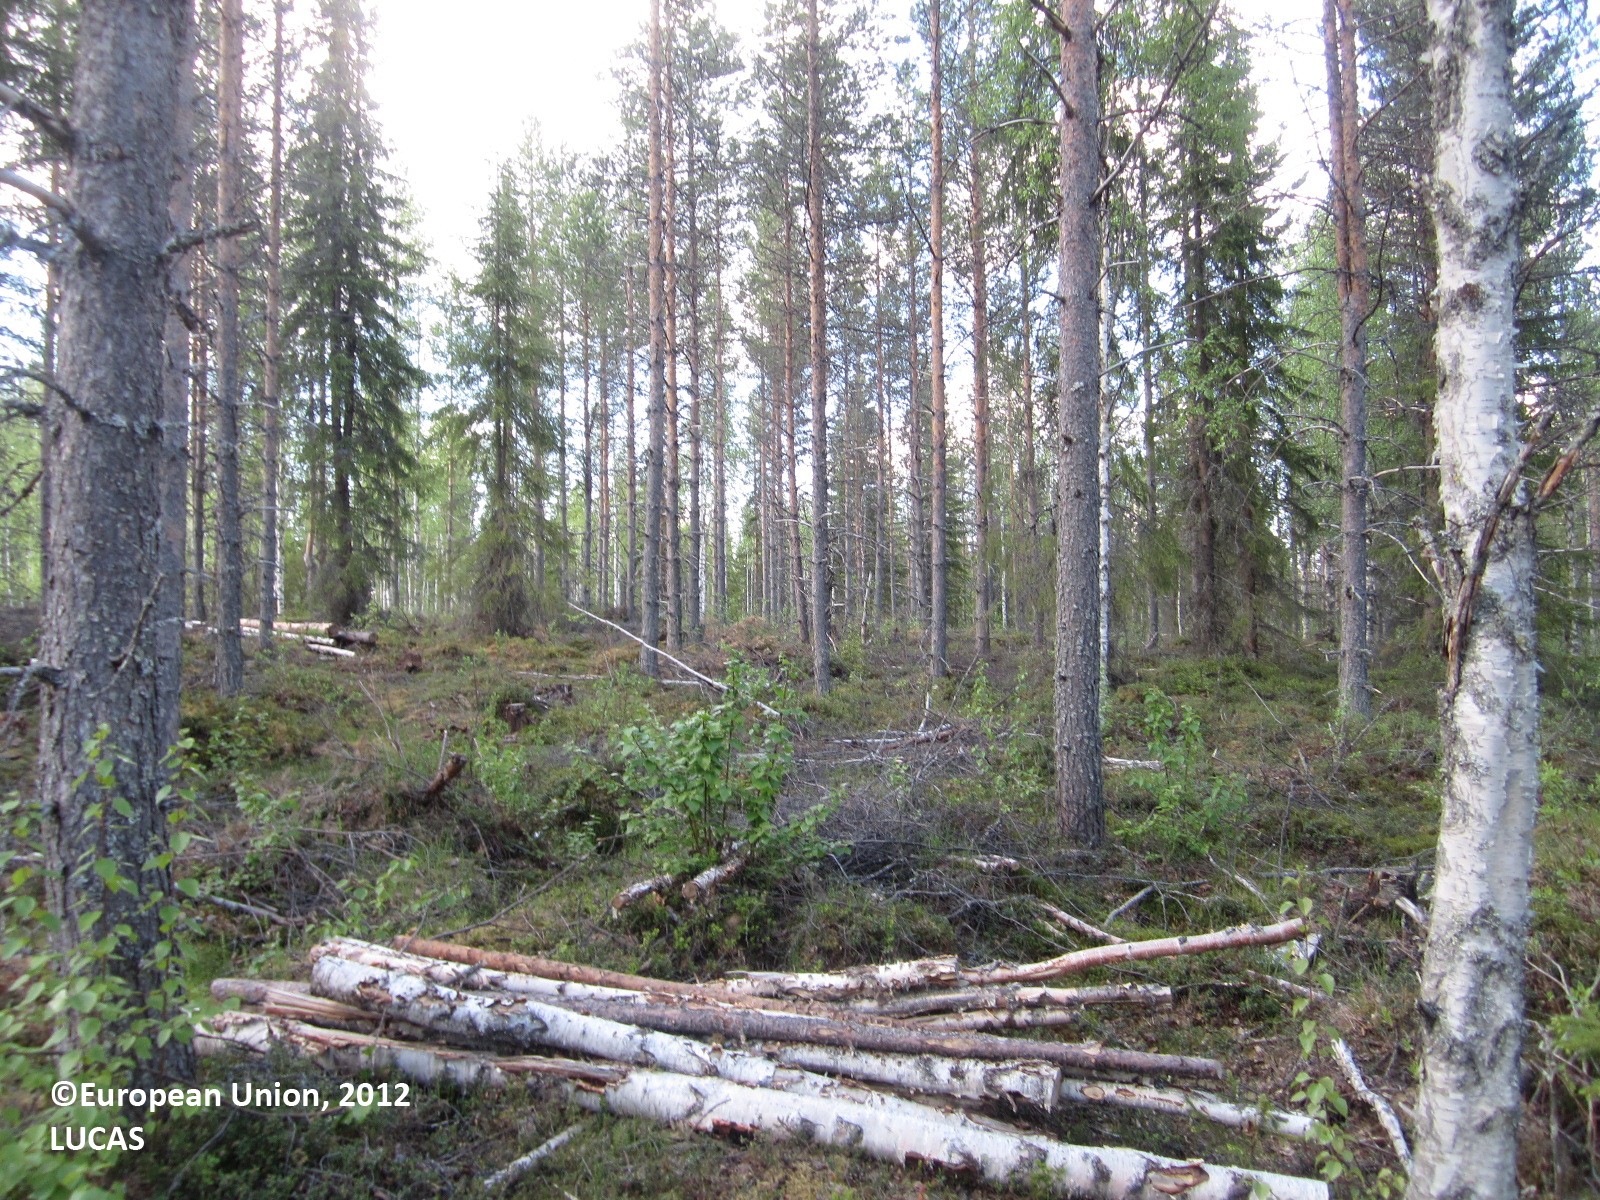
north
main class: Woodland
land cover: Pine dominated mixed woodland
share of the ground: 25 - 50 %
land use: Forestry
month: June
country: FI
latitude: 64.6422
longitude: 28.7887
